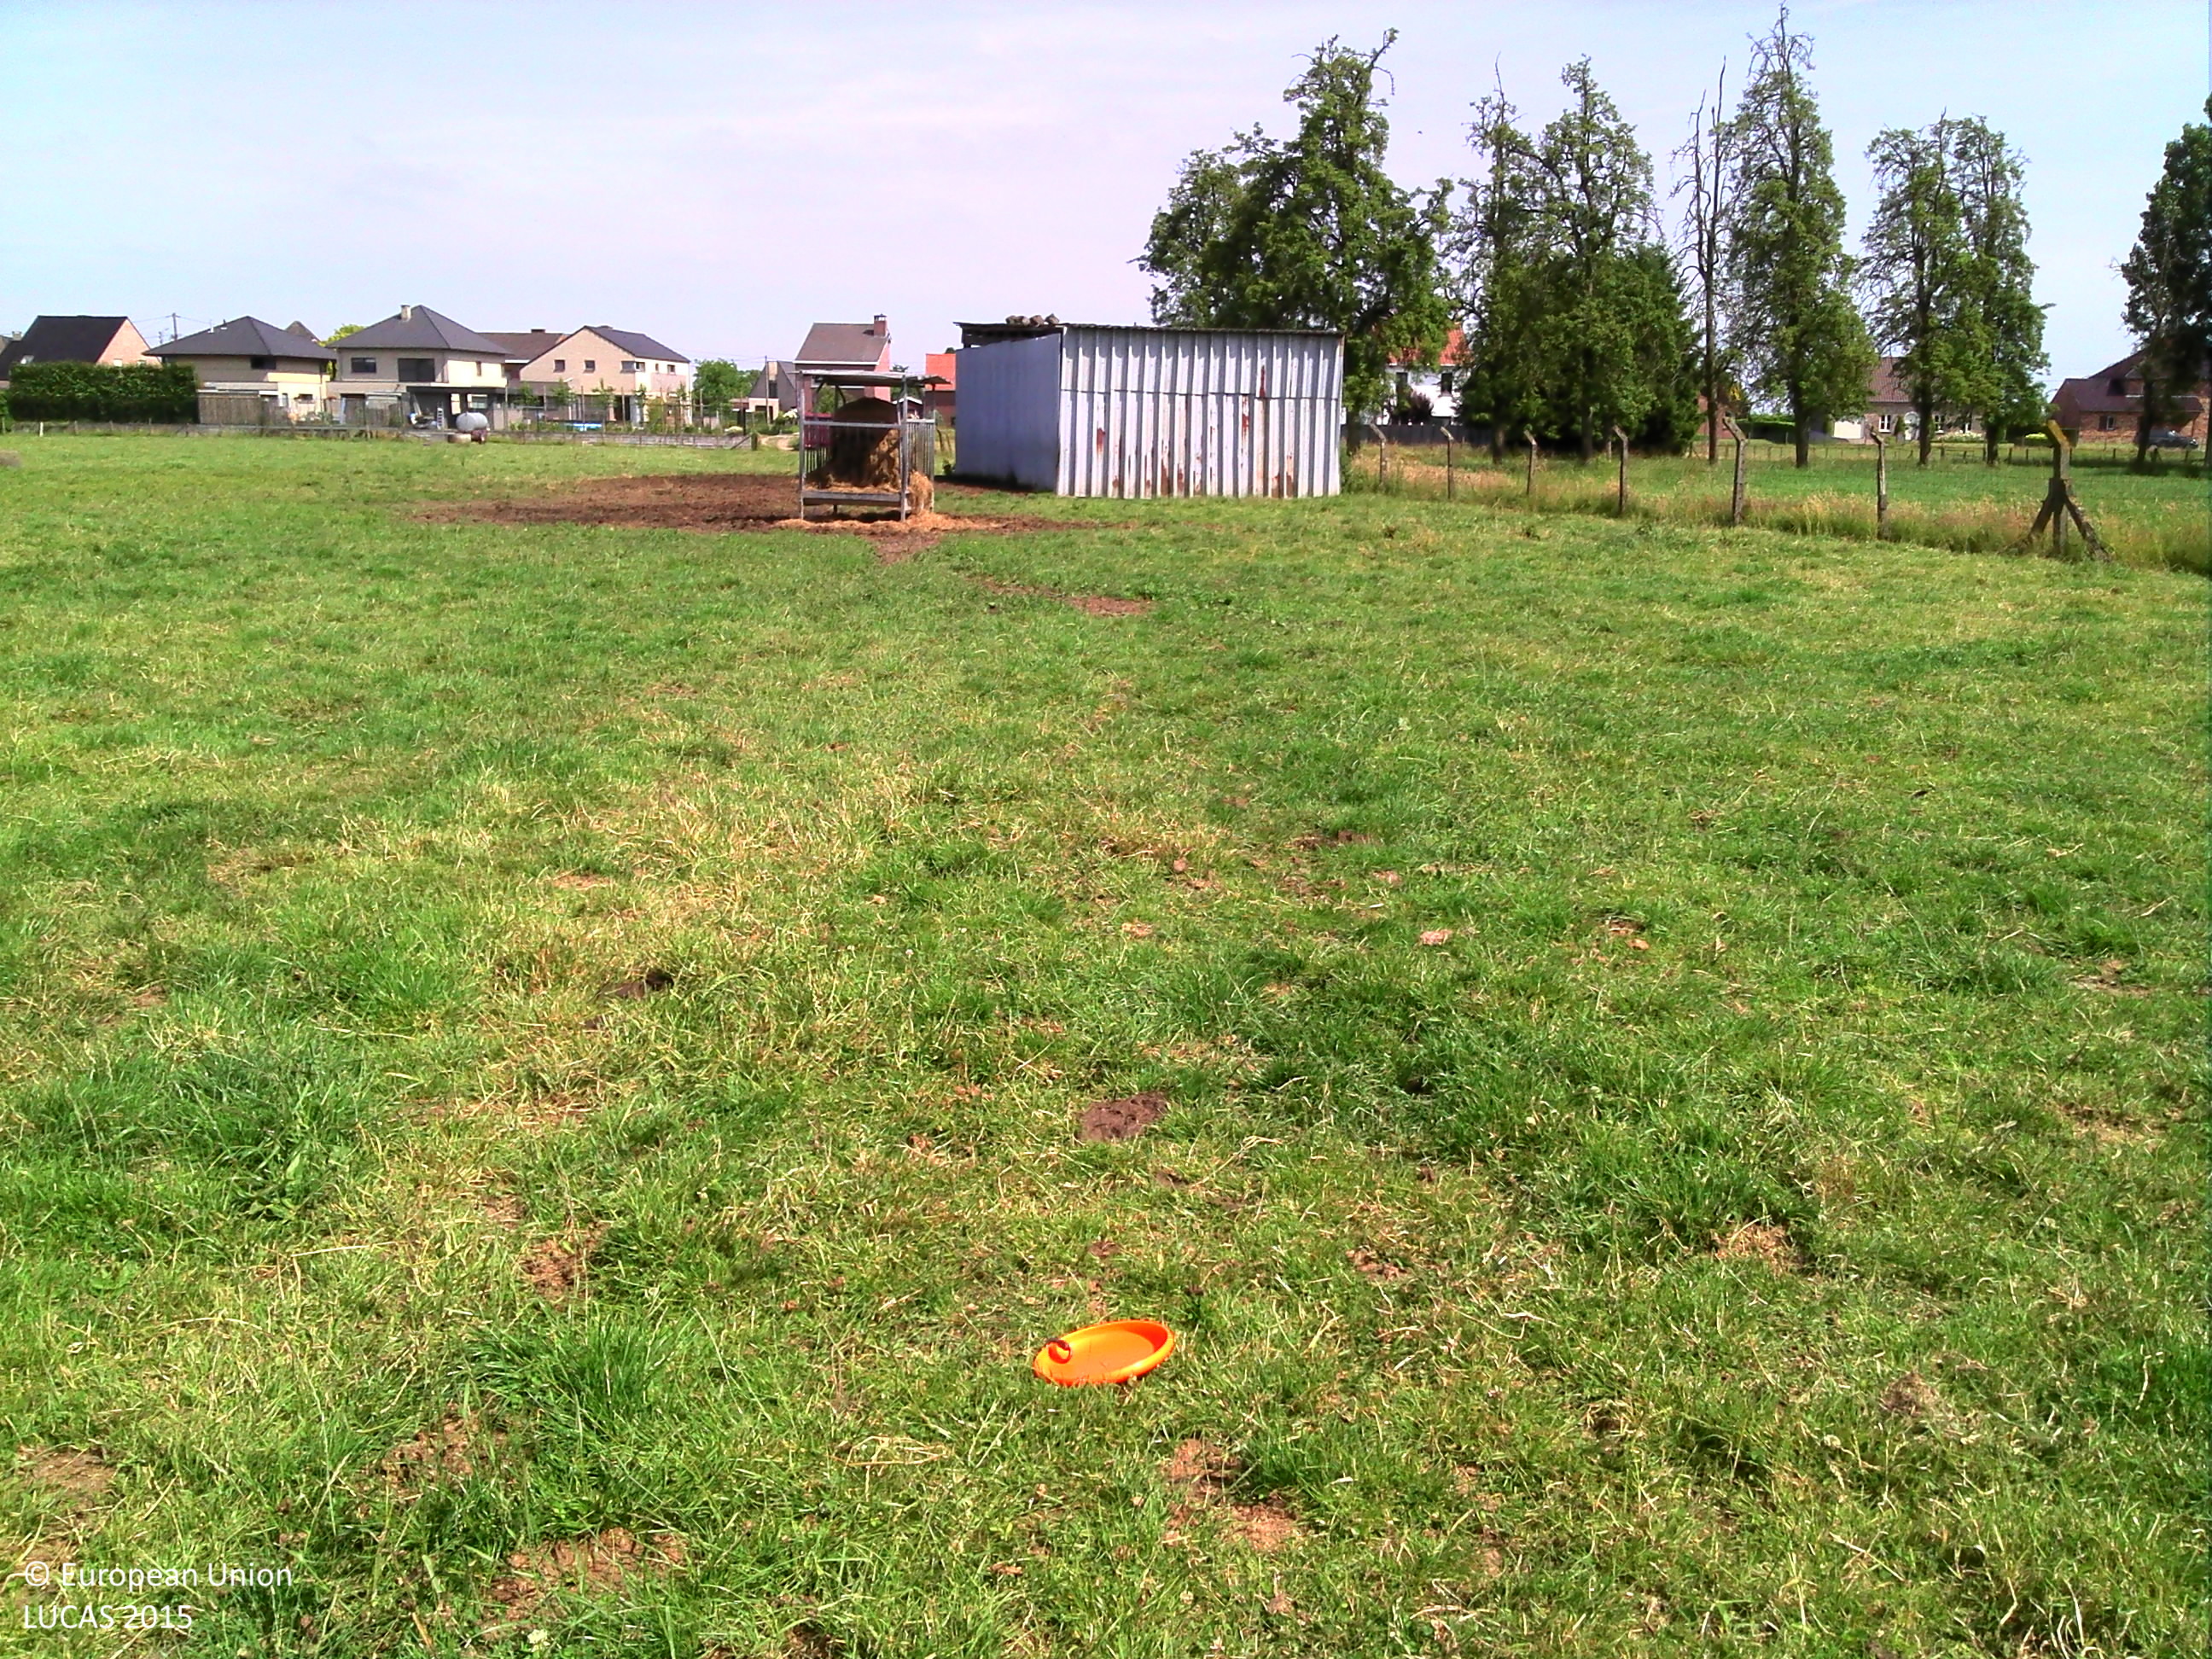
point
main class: Grassland
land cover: Grassland without tree/shrub cover
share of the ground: > 75 %
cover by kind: herbaceous plants 100 %
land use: Agriculture (excluding fallow land and kitchen gardens)
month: June
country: BE
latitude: 50.8729
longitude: 5.5787
